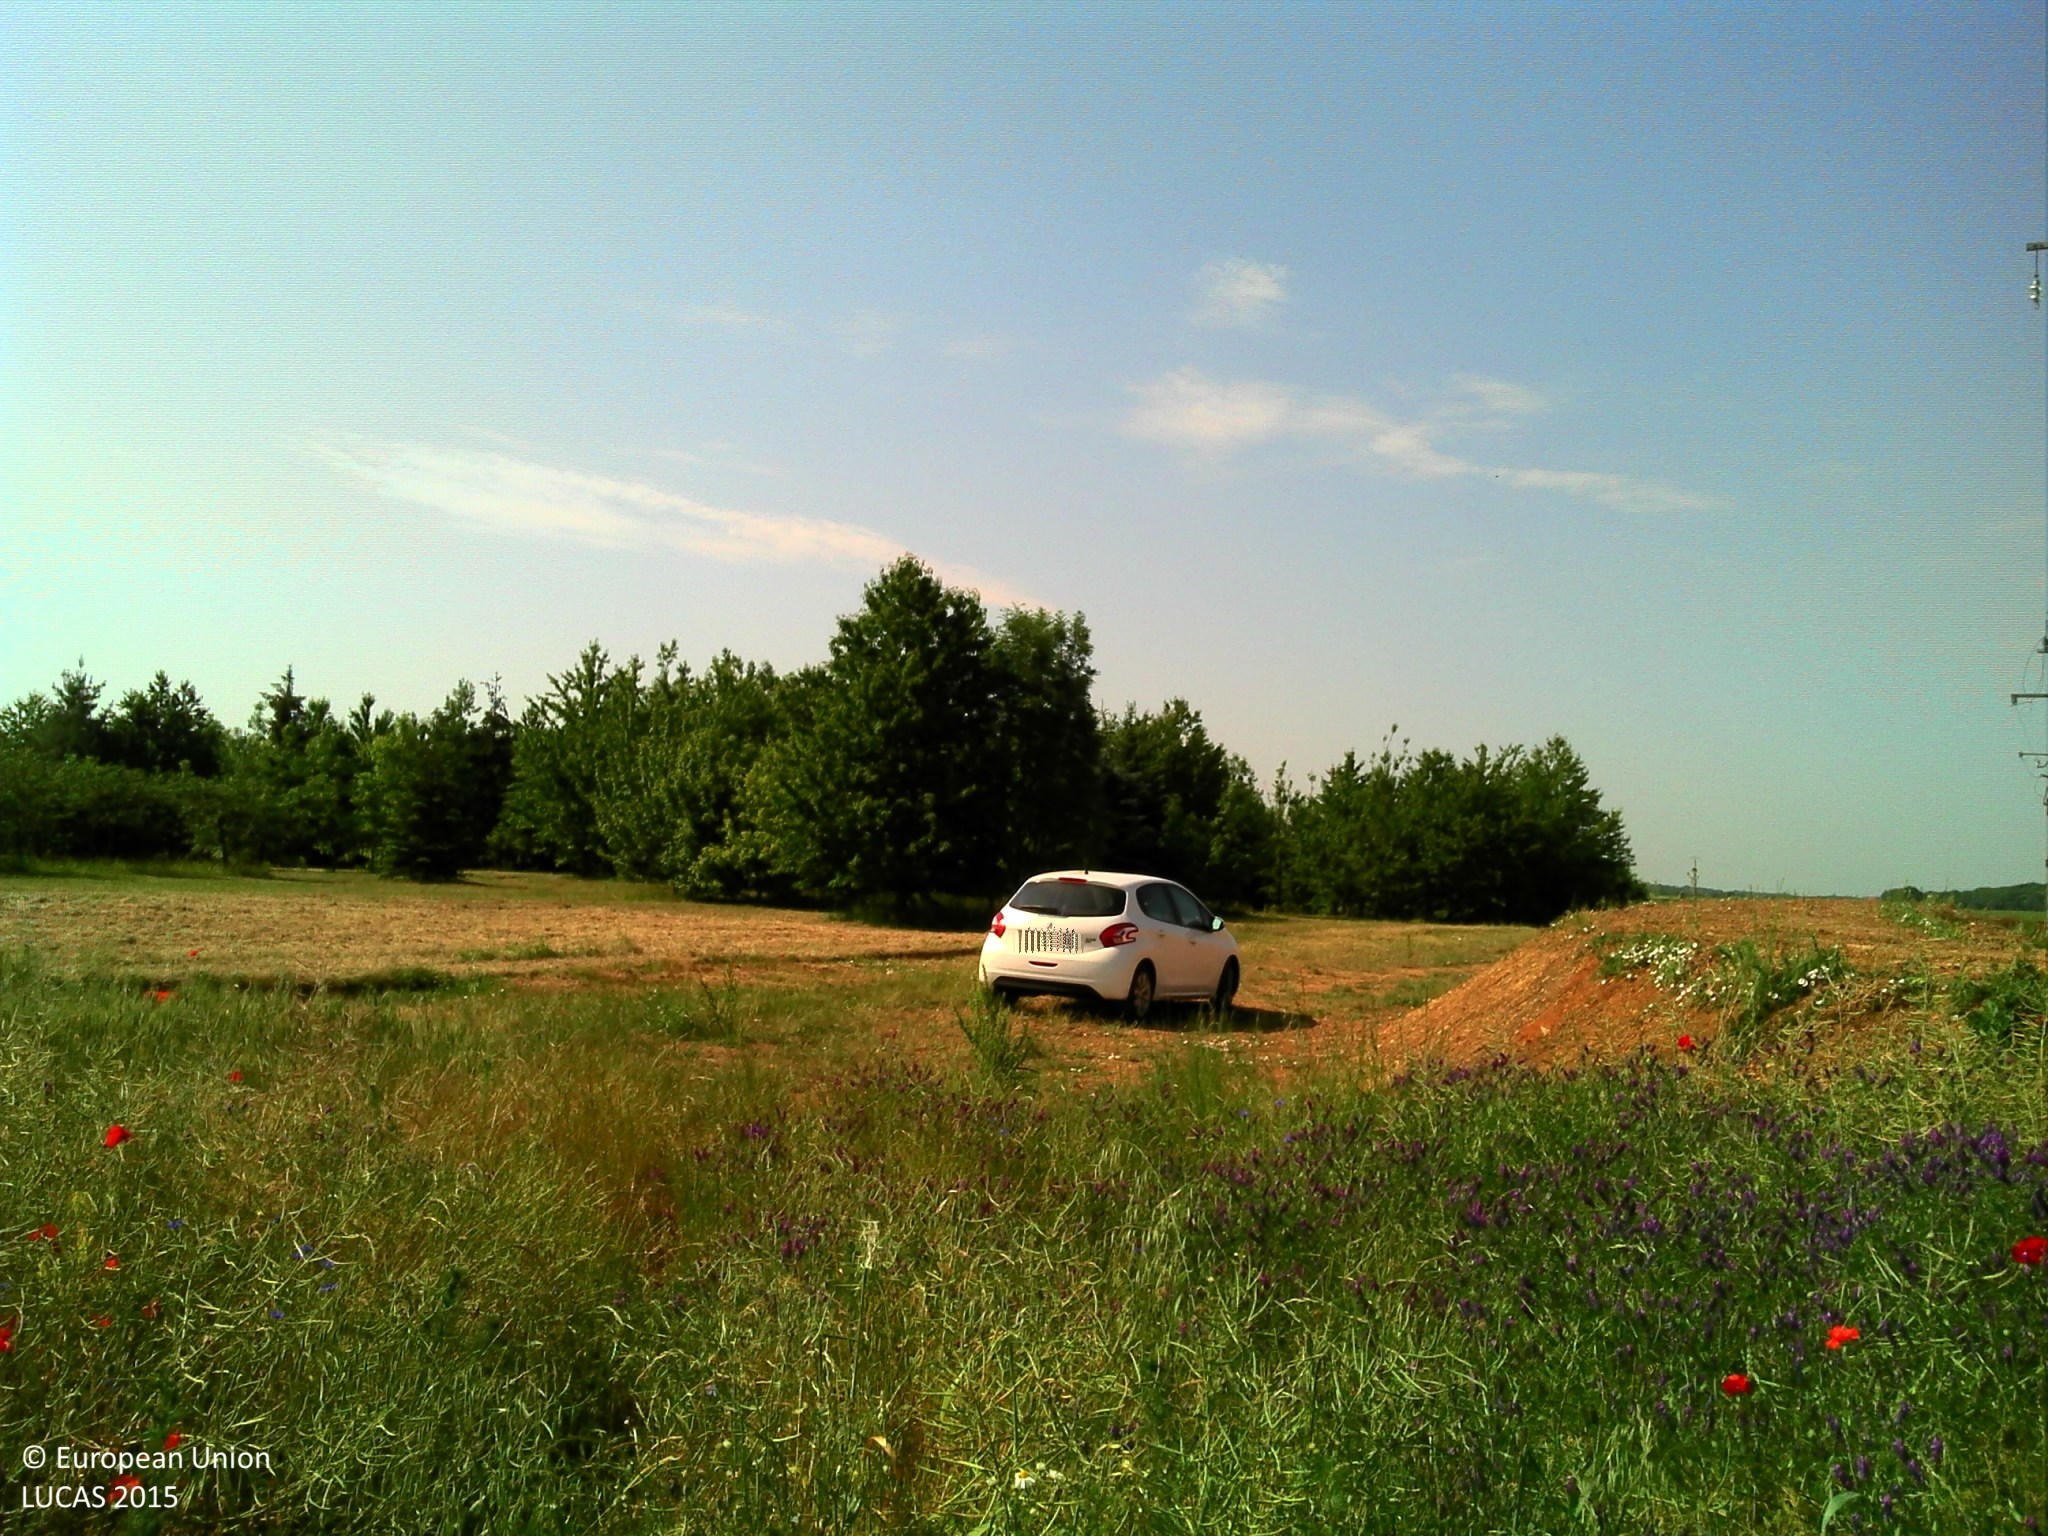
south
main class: Cropland
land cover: Rape and turnip rape
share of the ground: > 75 %
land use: Agriculture (excluding fallow land and kitchen gardens)
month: June
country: FR
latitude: 47.2647
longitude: 5.0445
